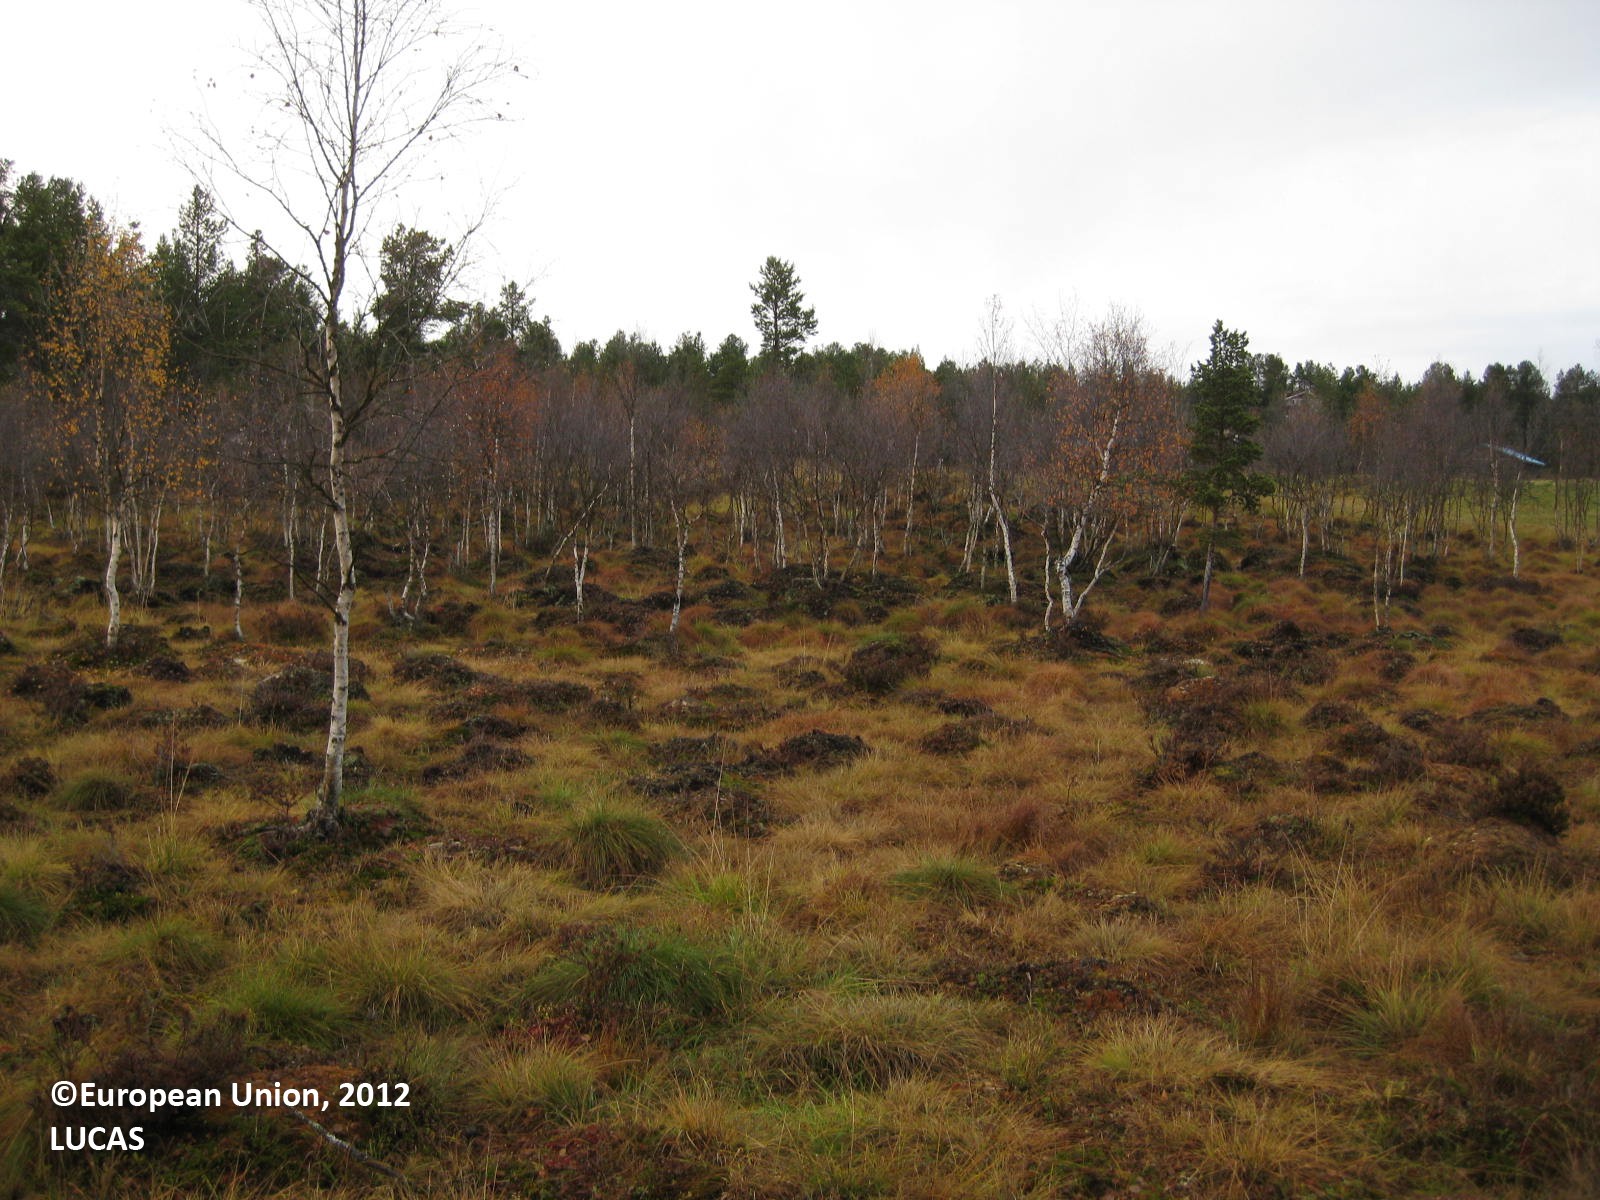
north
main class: Woodland
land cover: Broadleaved woodland
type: boreal forest
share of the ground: 25 - 50 %
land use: Agriculture (excluding fallow land and kitchen gardens)
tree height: > 5 m
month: September
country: FI
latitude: 68.4397
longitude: 24.0308
